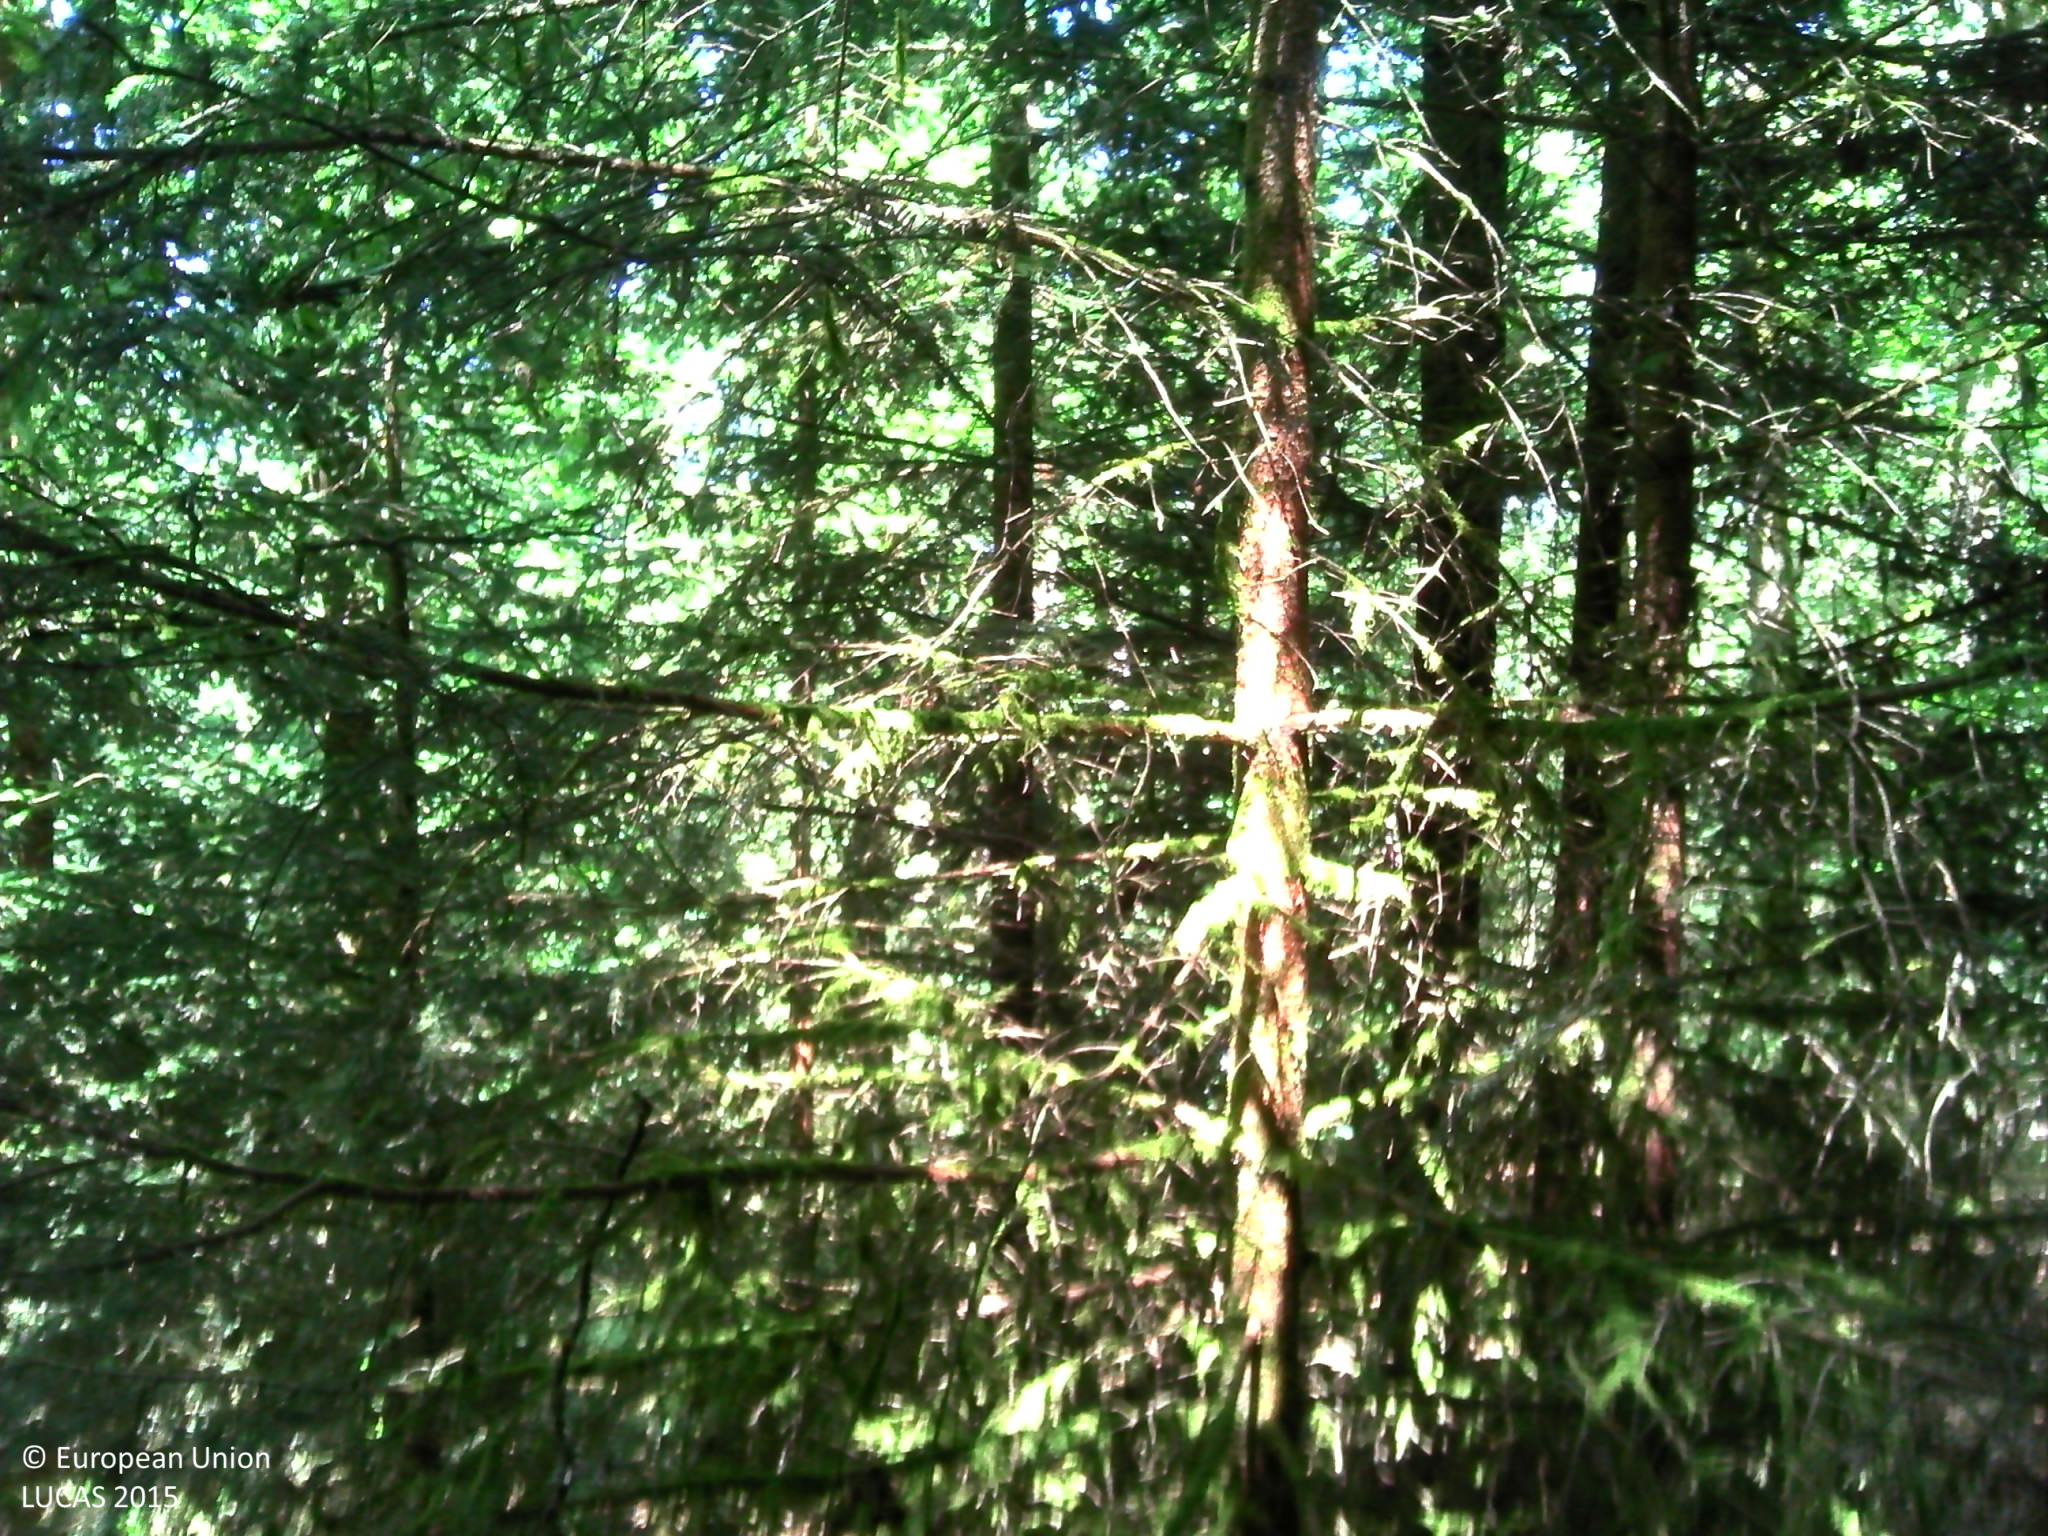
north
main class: Woodland
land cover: Spruce dominated mixed woodland
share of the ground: > 75 %
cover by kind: broadleaved forest trees 60 %, coniferous forest trees 40 %
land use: Forestry
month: July
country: BE
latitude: 50.0801
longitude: 5.5685
